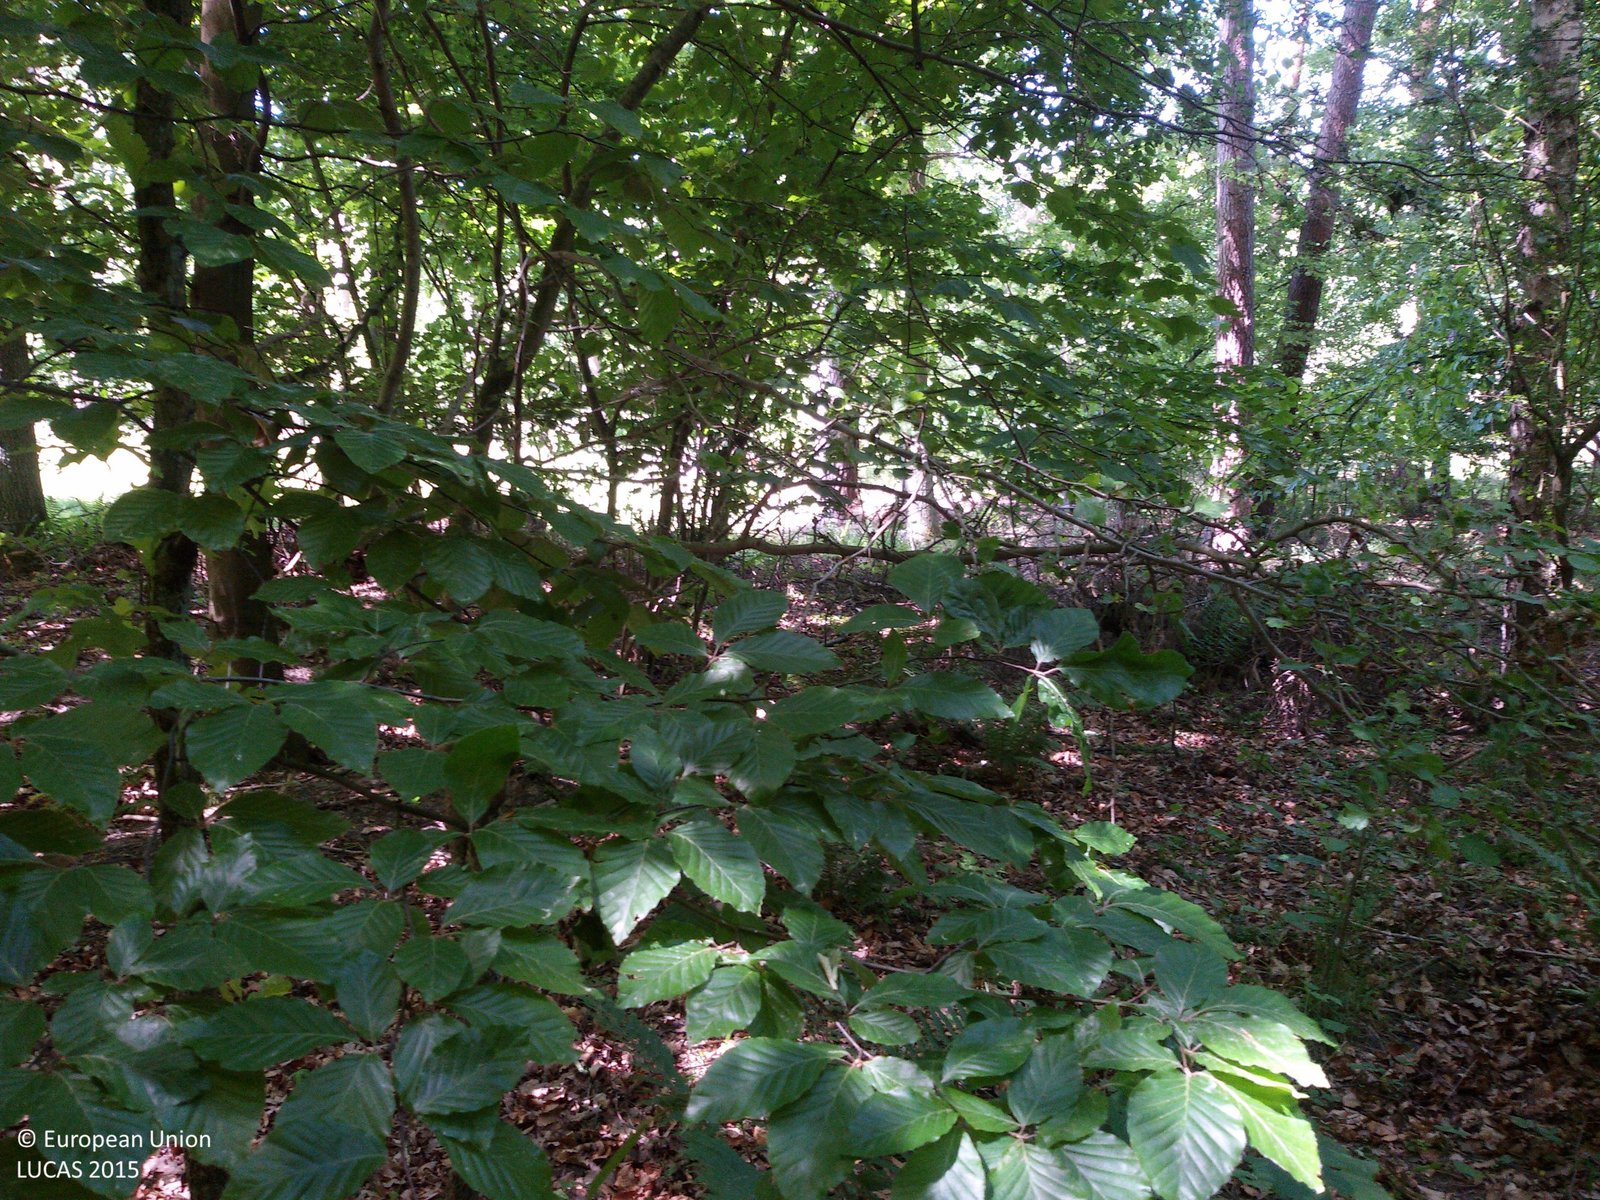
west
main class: Woodland
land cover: Broadleaved woodland
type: mesophytic deciduous forest
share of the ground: > 75 %
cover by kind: broadleaved forest trees 80 %, shrubs 10 %, herbaceous plants 10 %
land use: Forestry
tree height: > 5 m
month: June
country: PL
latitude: 53.2925
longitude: 17.2566
